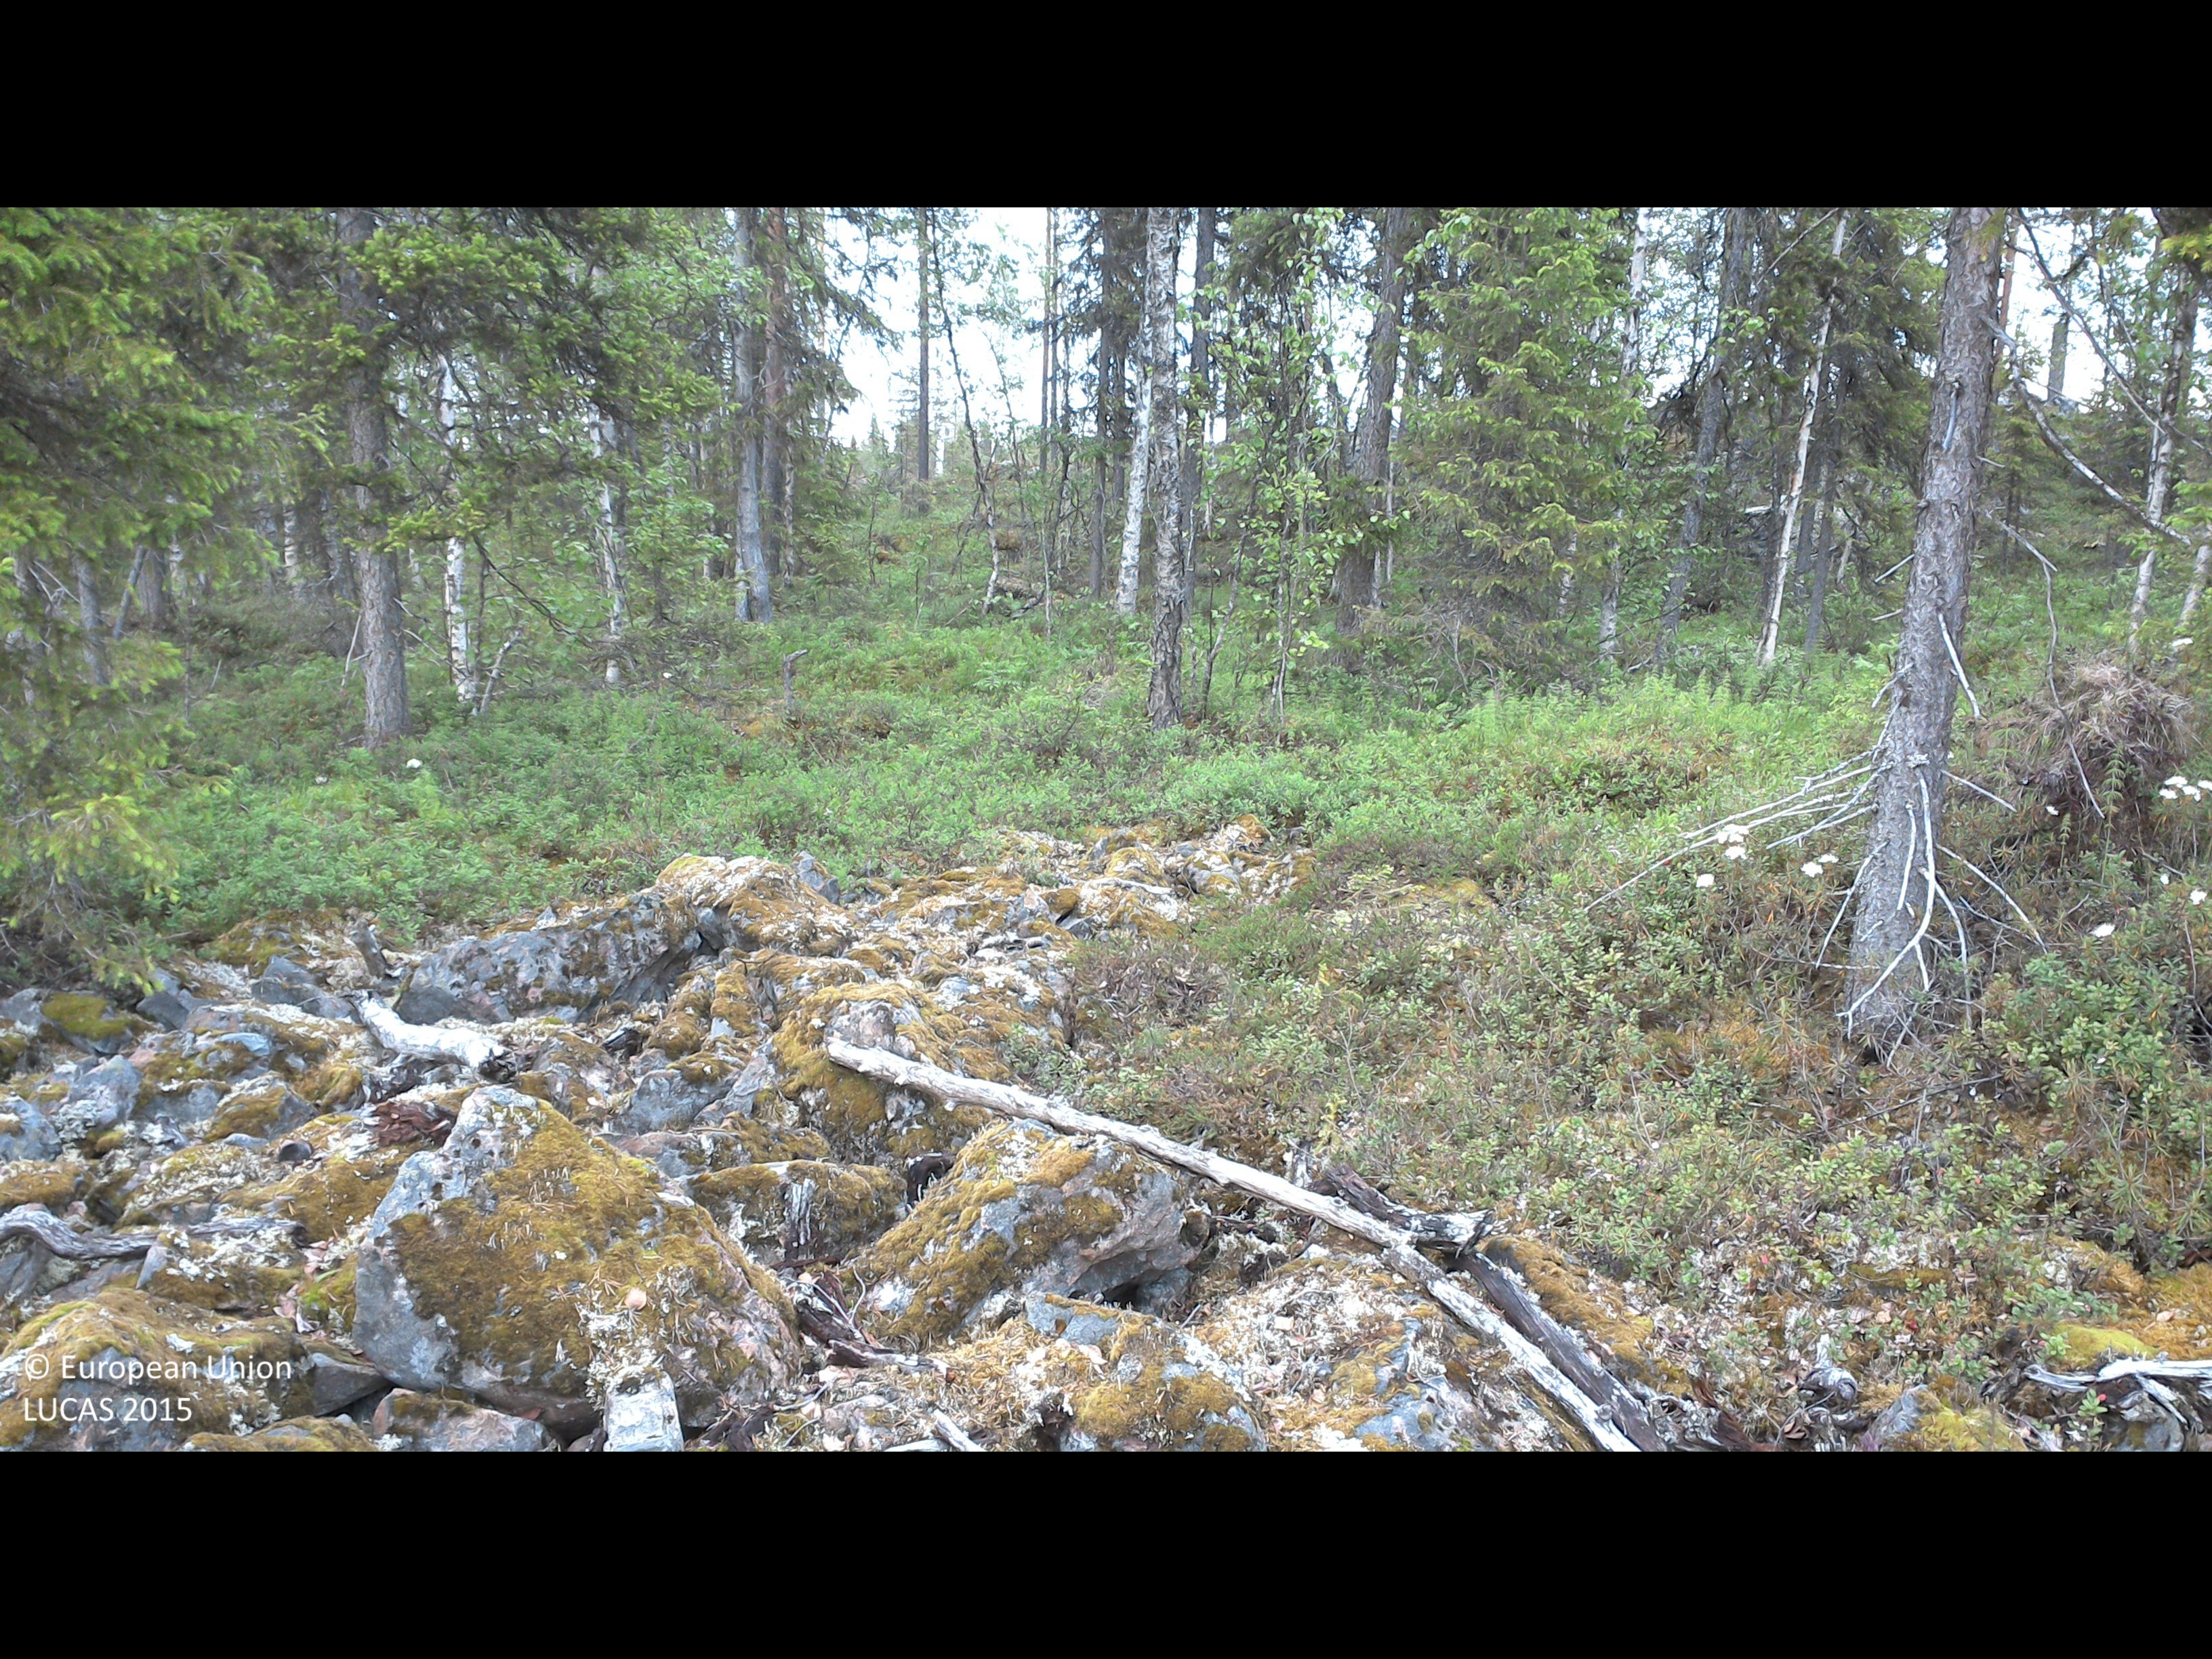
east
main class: Woodland
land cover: Spruce dominated coniferous woodland
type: boreal forest
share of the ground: > 75 %
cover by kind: shrubs 55 %, lichens and mosses 20 %, coniferous forest trees 15 %, broadleaved forest trees 5 %, unconsolidated bare surface 5 %
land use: Forestry
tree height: > 5 m
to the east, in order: Spruce dominated coniferous woodland; Rock outcrops; Spruce dominated mixed woodland; Pine dominated mixed woodland; Other bare soil; Shrubland with sparse tree cover; Pine dominated mixed woodland; Lichens and moss
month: June
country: SE
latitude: 66.9165
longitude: 22.6991
